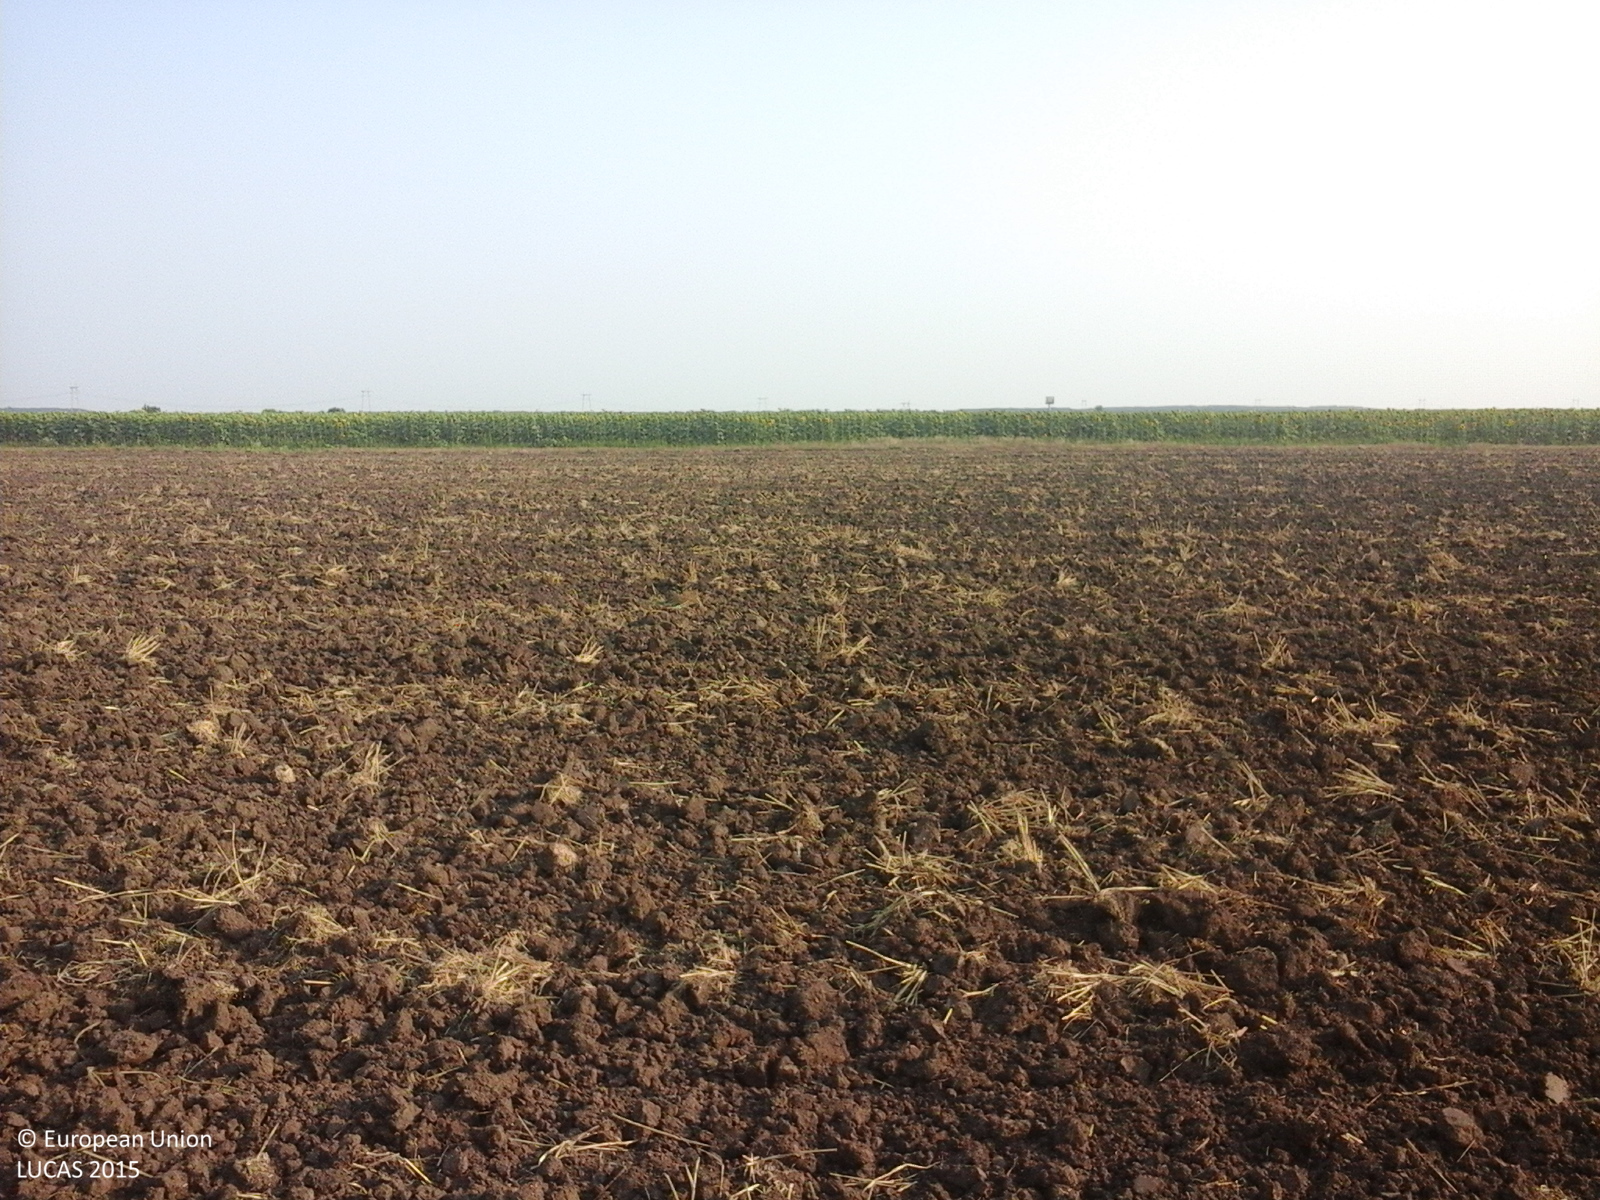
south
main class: Cropland
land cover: Common wheat
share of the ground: < 10 %
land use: Agriculture (excluding fallow land and kitchen gardens)
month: July
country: RO
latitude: 44.4481
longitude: 26.4108
